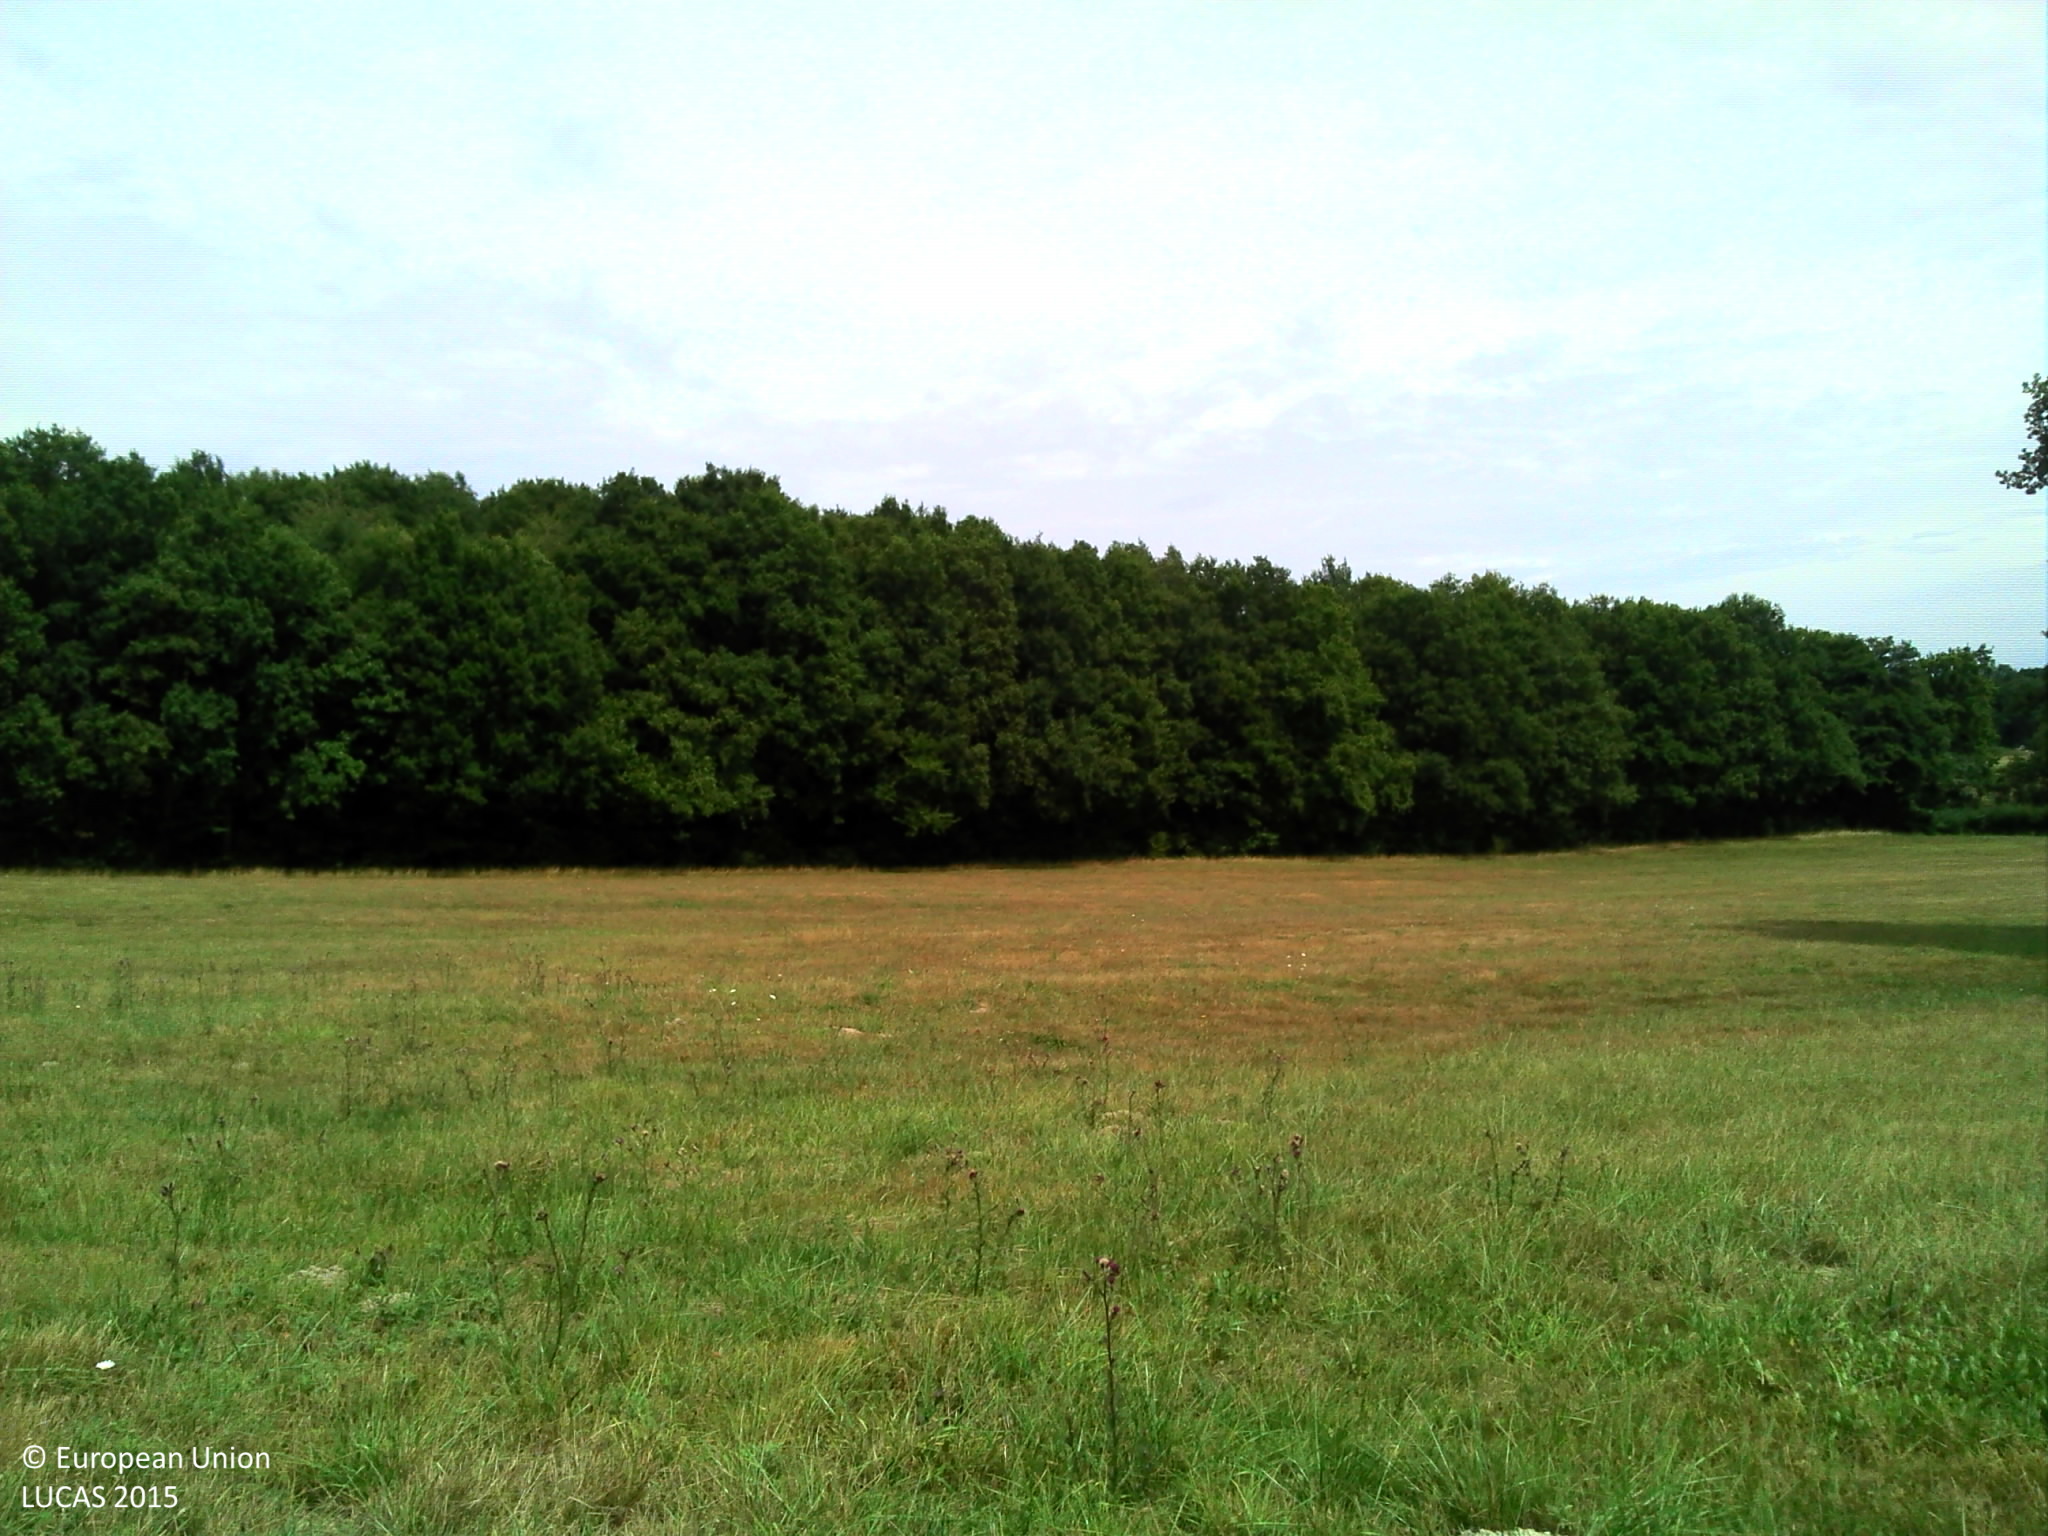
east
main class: Grassland
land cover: Grassland without tree/shrub cover
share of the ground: > 75 %
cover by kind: herbaceous plants 100 %
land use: Agriculture (excluding fallow land and kitchen gardens)
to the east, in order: Grassland without tree/shrub cover; Broadleaved woodland
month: July
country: FR
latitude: 46.5575
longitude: 2.7566
